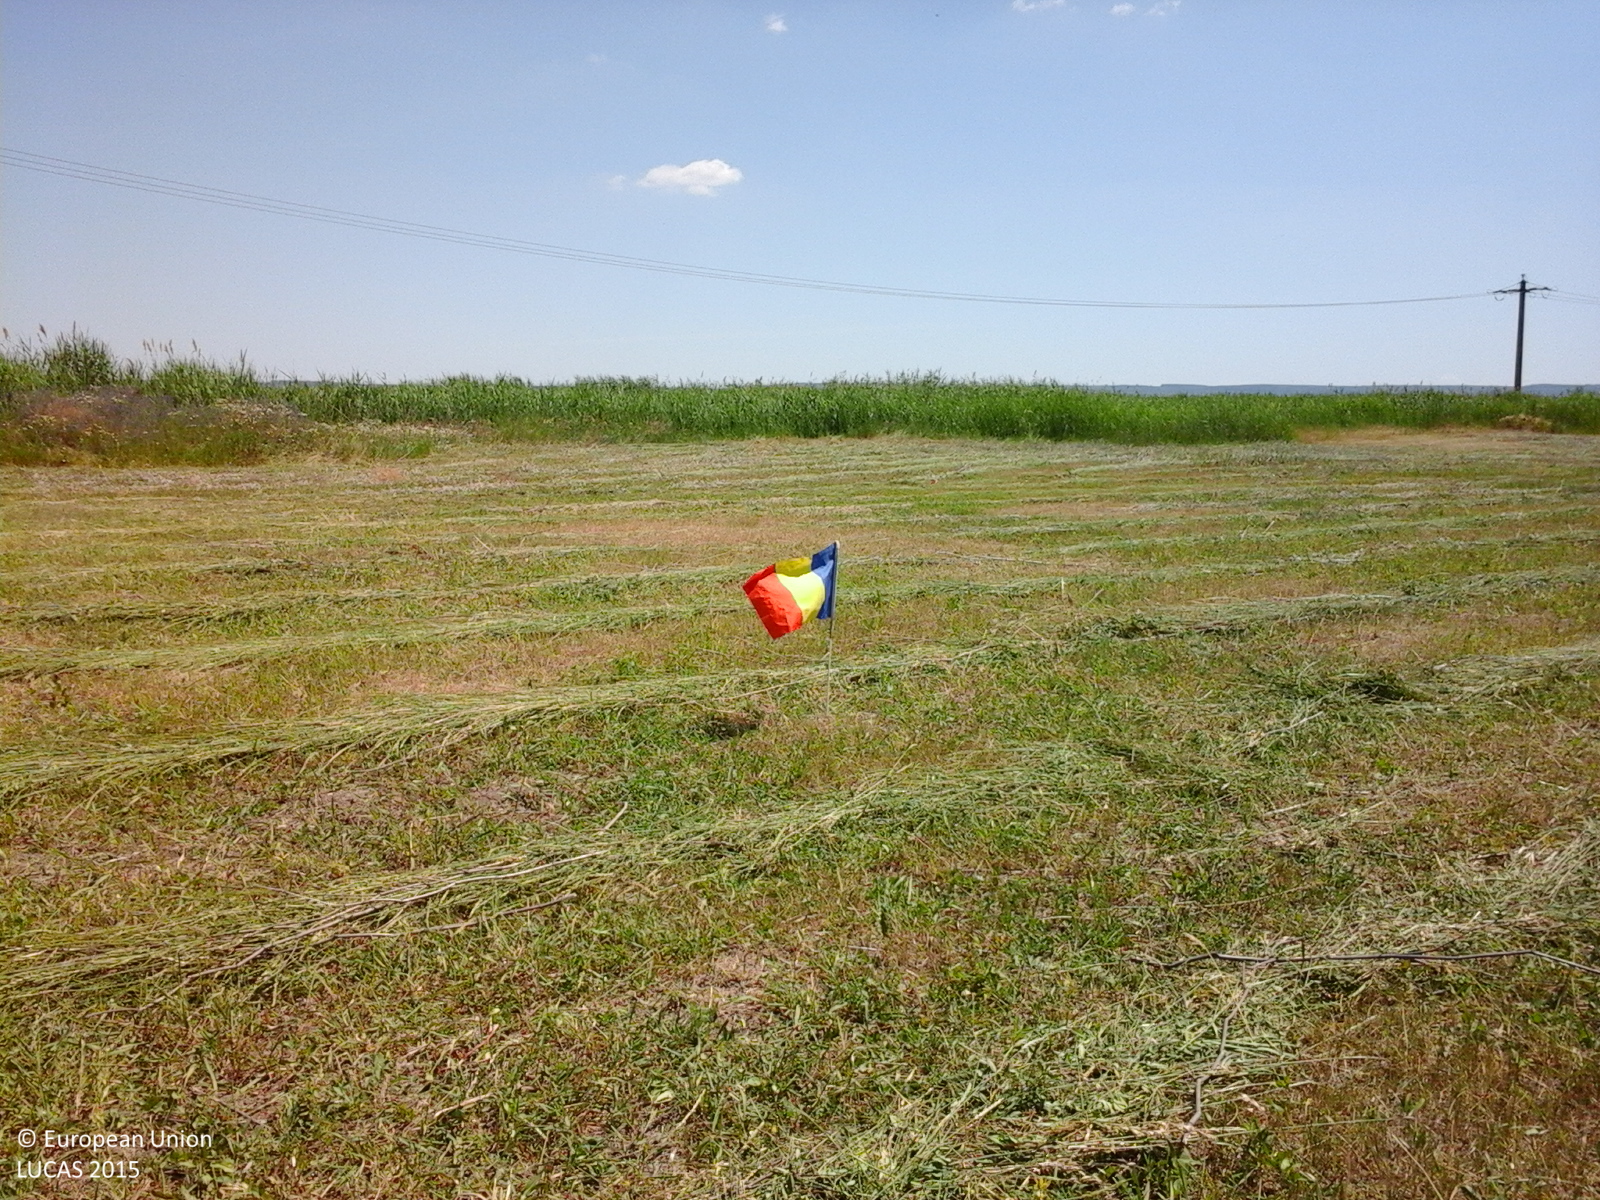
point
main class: Grassland
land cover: Grassland without tree/shrub cover
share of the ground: > 75 %
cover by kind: herbaceous plants 100 %
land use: Agriculture (excluding fallow land and kitchen gardens)
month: June
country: RO
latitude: 47.0012
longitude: 28.0034
